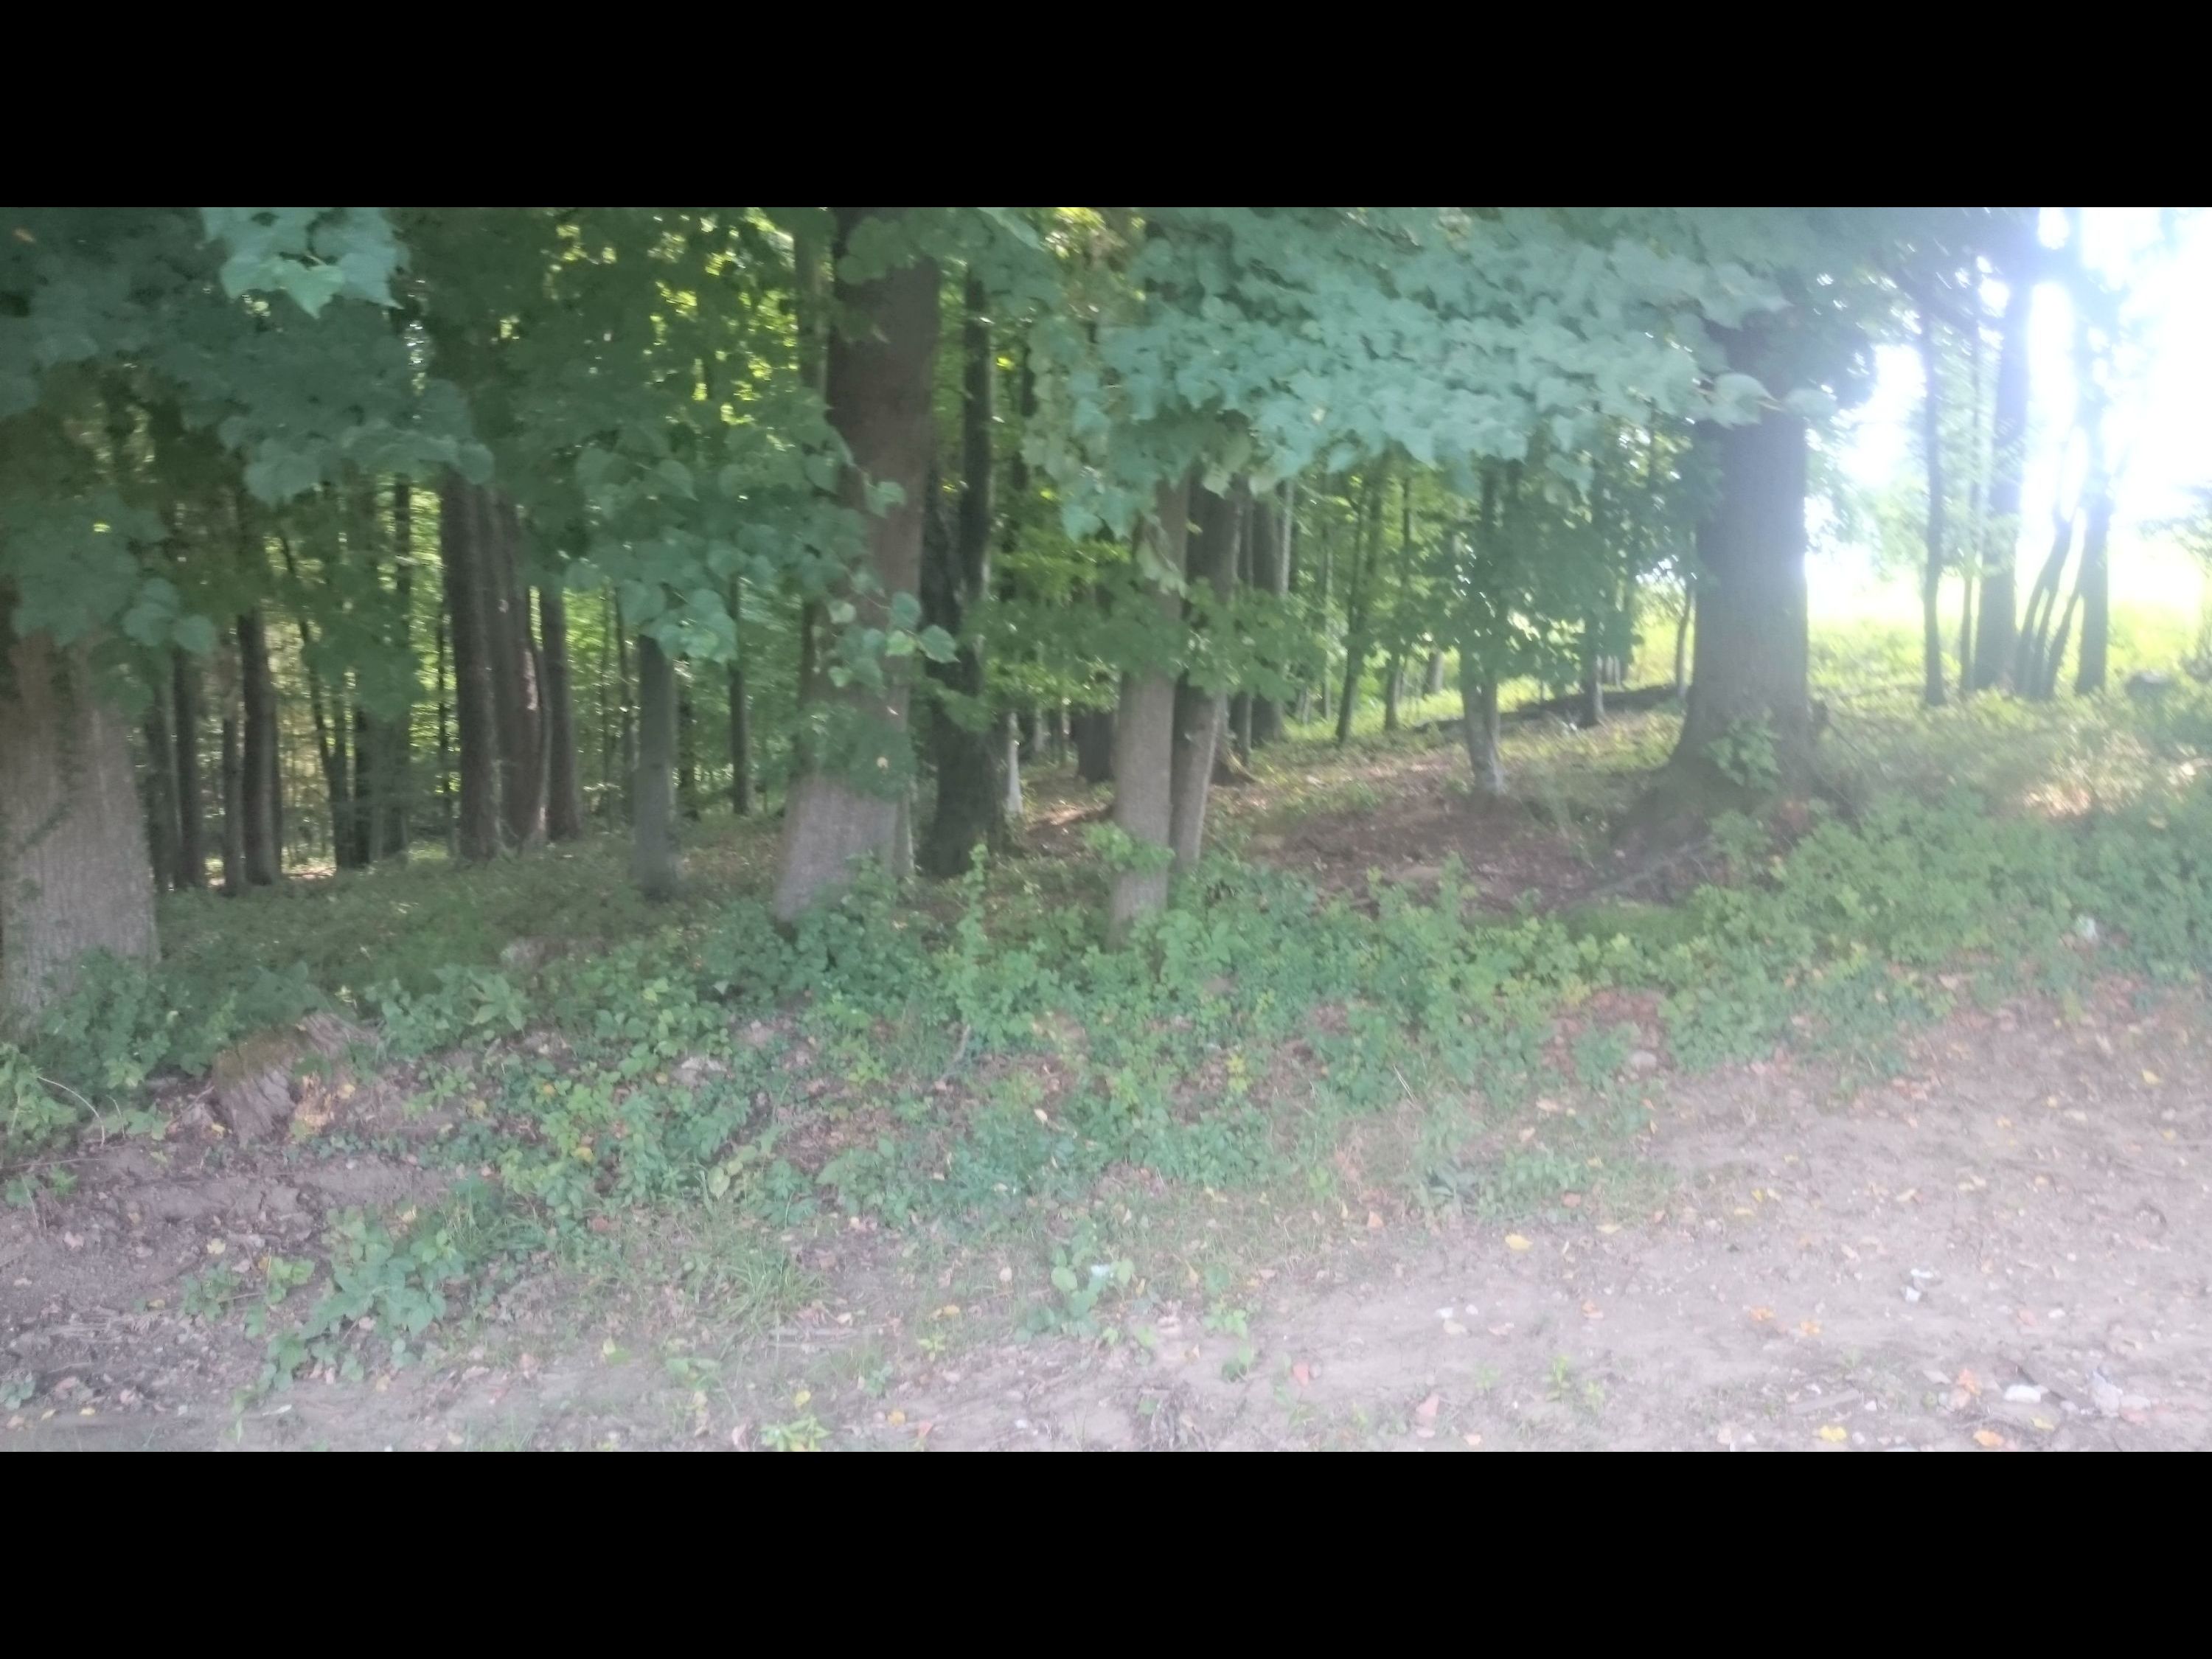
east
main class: Cropland
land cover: Apple fruit
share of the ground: > 75 %
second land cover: Grassland without tree/shrub cover
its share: > 75 %
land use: Agriculture (excluding fallow land and kitchen gardens)
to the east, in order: Apple fruit; Grassland without tree/shrub cover; Apple fruit; Fences; Tracks; Broadleaved woodland; Tracks; Broadleaved woodland
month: July
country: AT
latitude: 47.1070
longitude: 15.6007
